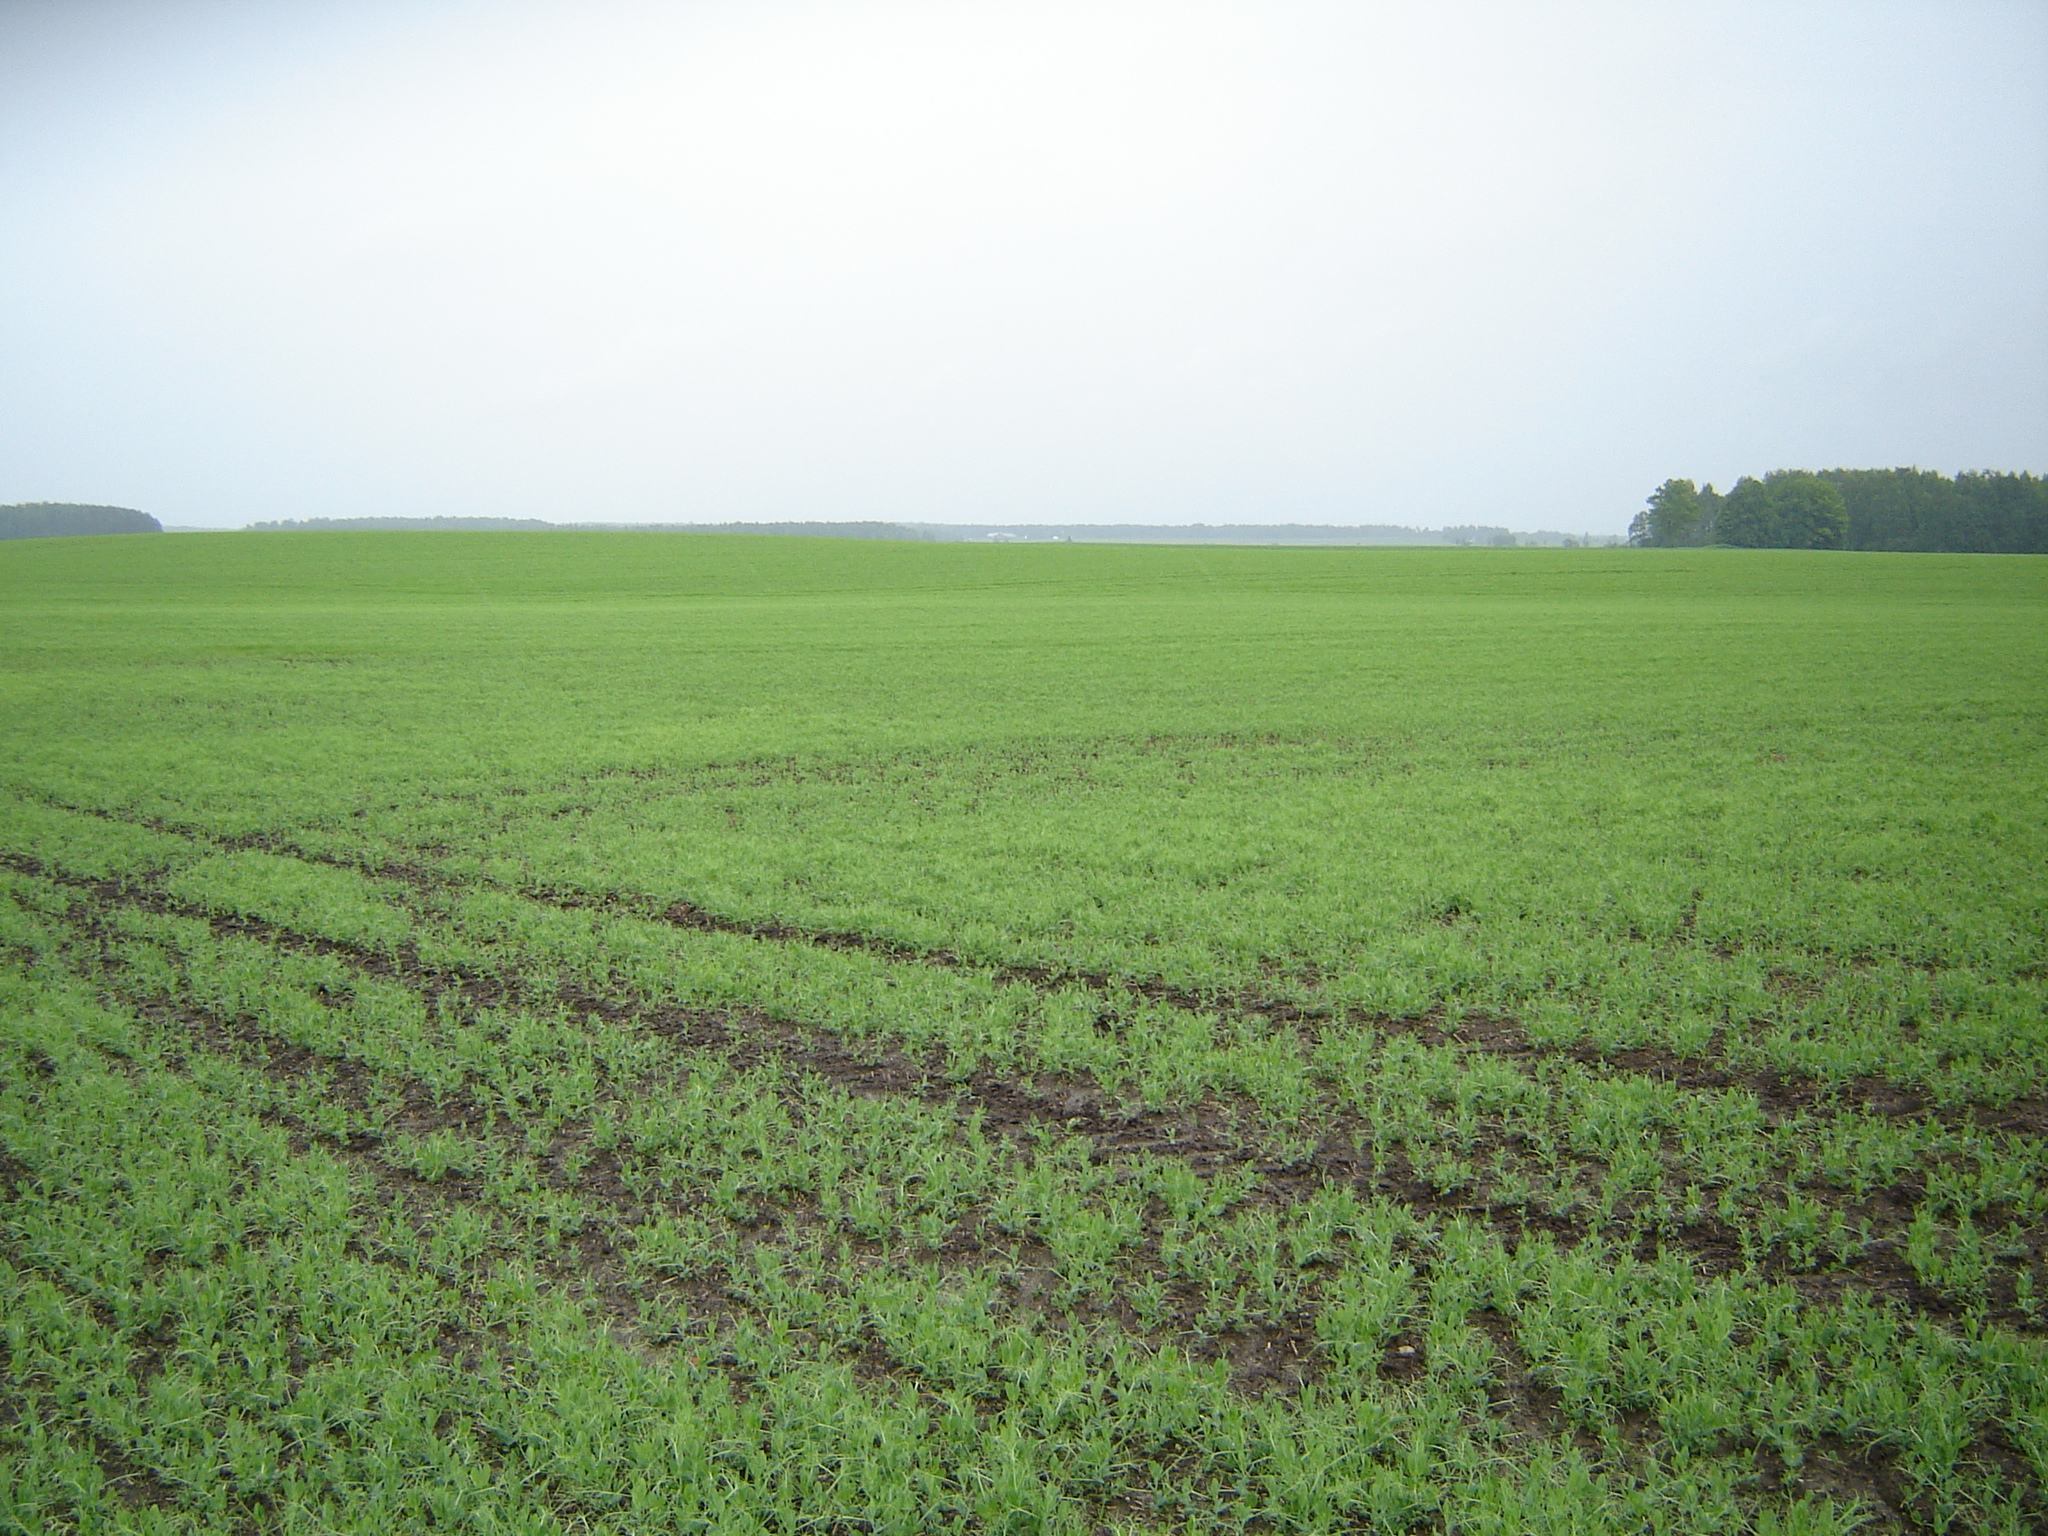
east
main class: Cropland
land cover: Dry pulses
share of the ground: > 75 %
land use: Agriculture (excluding fallow land and kitchen gardens)
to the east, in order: Dry pulses; Mixed cereals for fodder
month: May
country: LT
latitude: 55.9996
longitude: 25.2692
